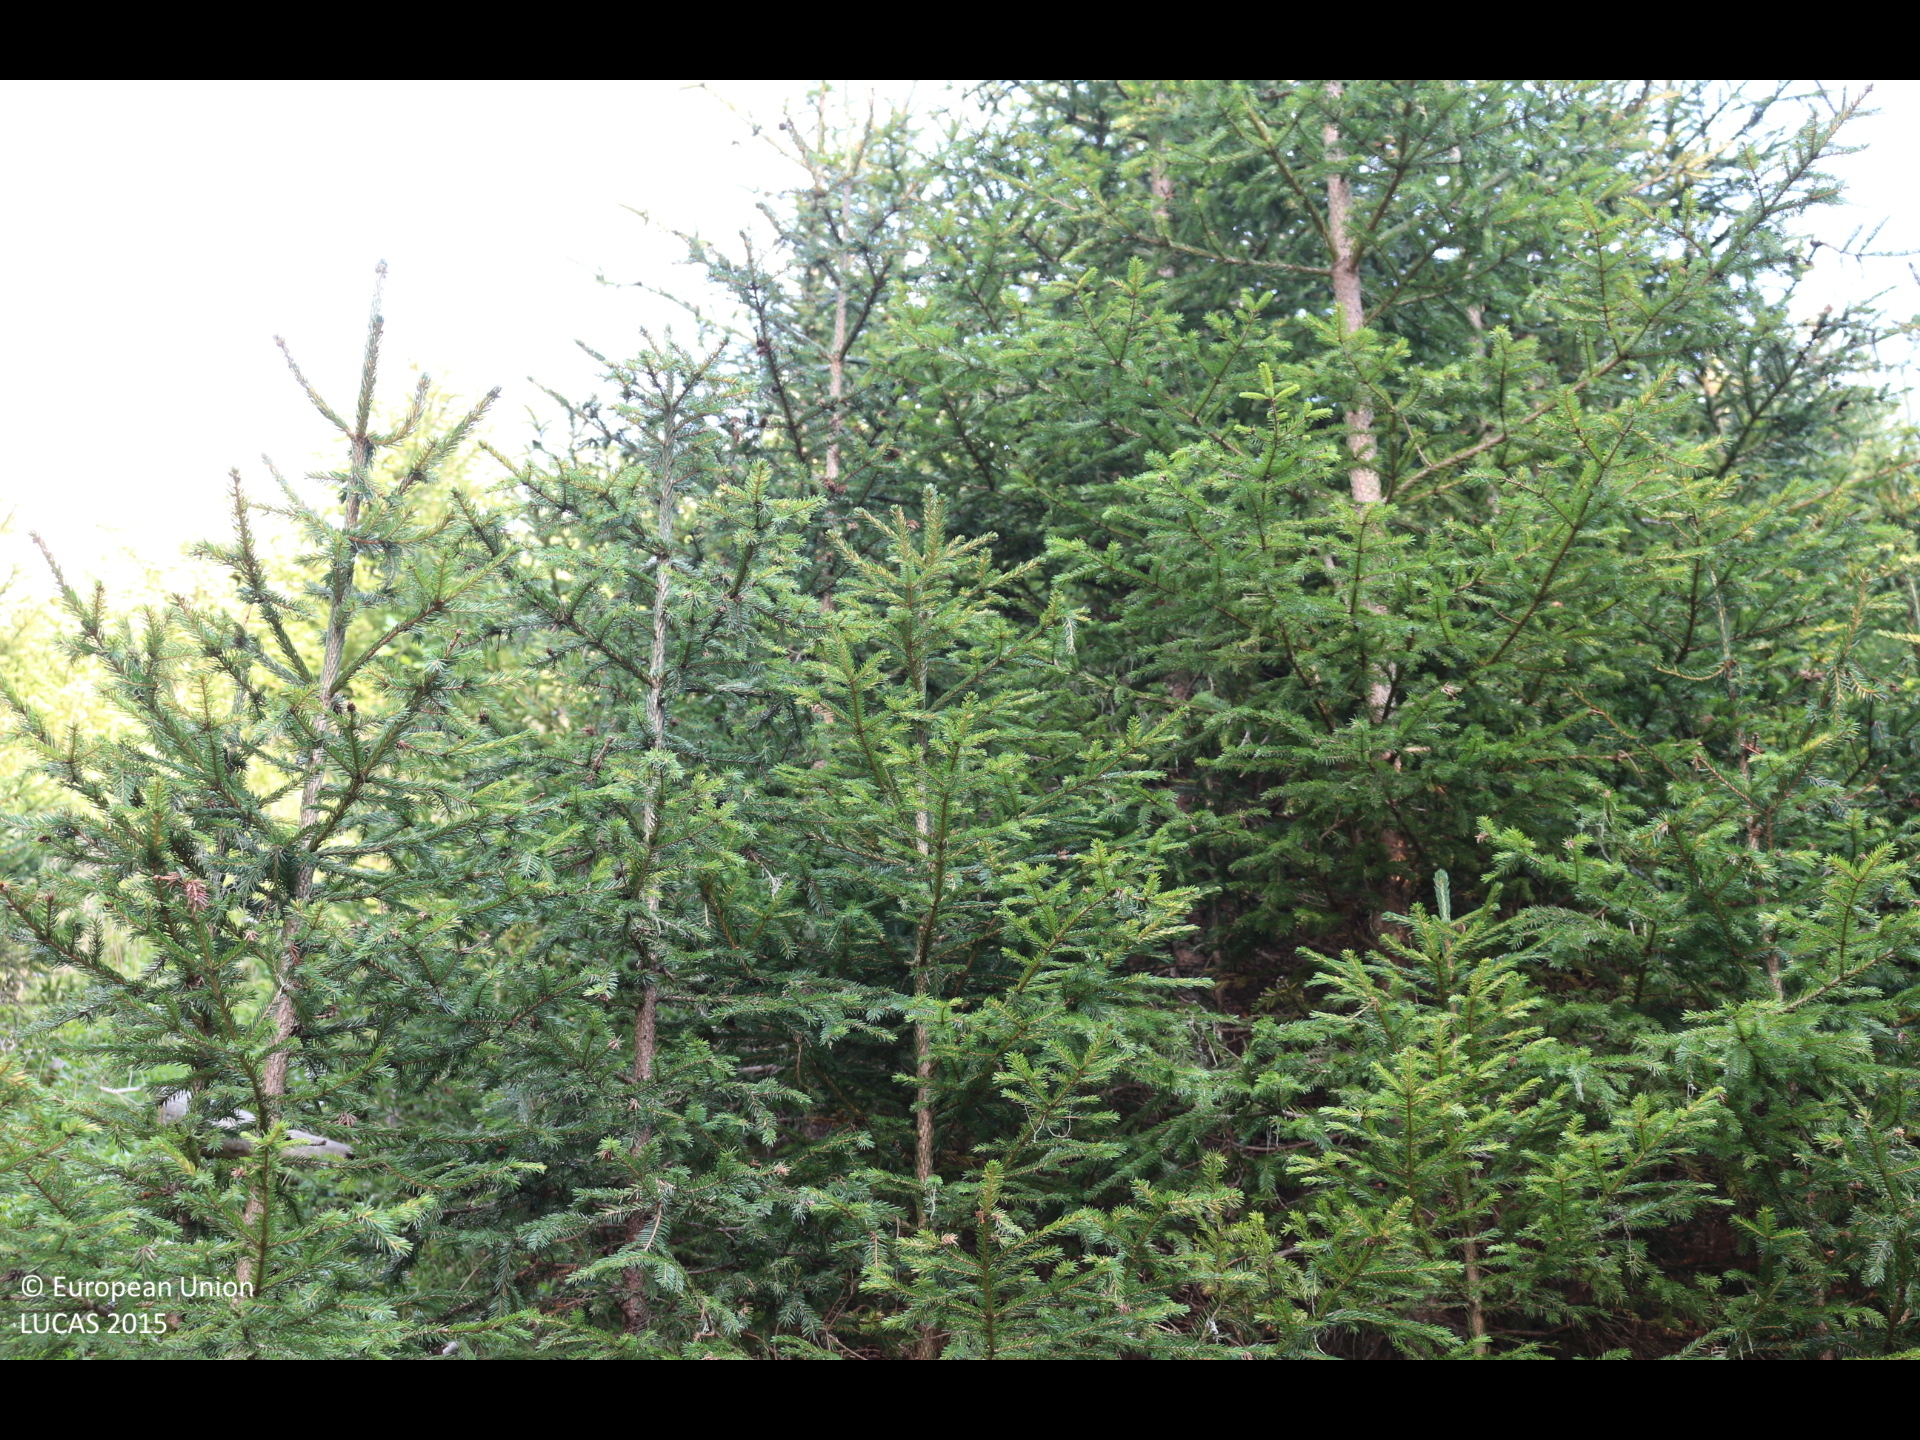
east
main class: Woodland
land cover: Spruce dominated coniferous woodland
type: alpine coniferous forest
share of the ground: > 75 %
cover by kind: coniferous forest trees 90 %, shrubs 5 %, lichens and mosses 5 %
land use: Forestry
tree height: > 5 m
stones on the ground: 10 - 25 %
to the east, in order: Spruce dominated coniferous woodland; Grassland with sparse tree/shrub cover; Spruce dominated coniferous woodland; Tracks; Spruce dominated coniferous woodland; Grassland with sparse tree/shrub cover; Fences; Grassland with sparse tree/shrub cover; Fences; Spontaneously vegetated surfaces
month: August
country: AT
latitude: 46.9793
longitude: 14.0074
